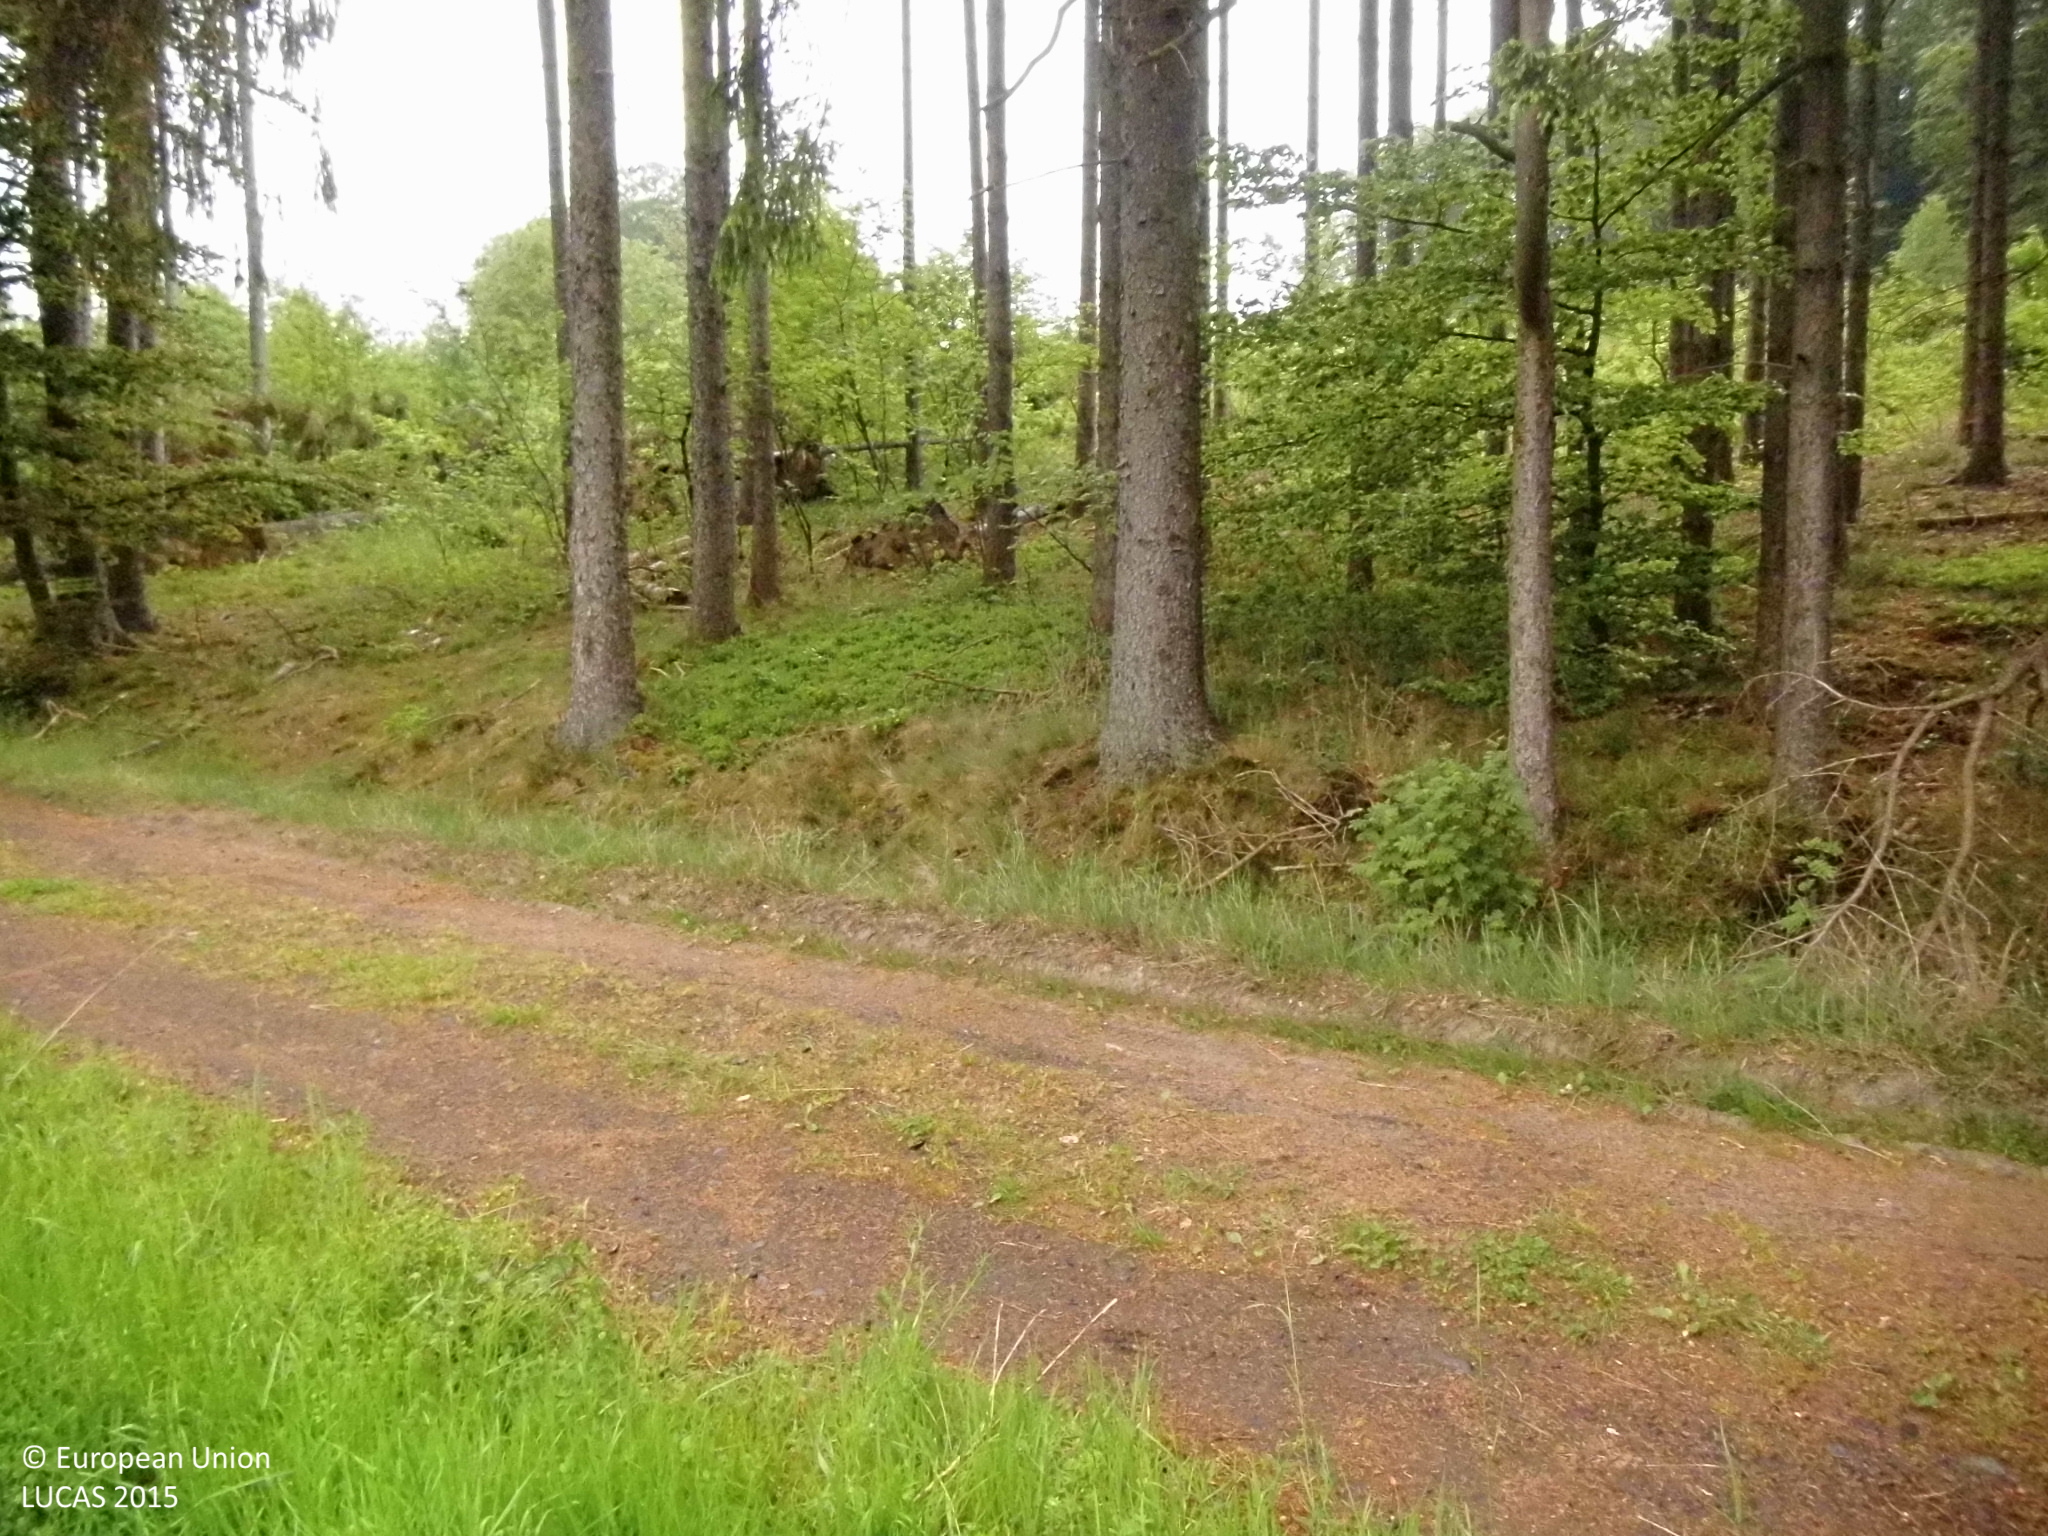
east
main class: Shrubland
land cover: Shrubland with sparse tree cover
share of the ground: > 75 %
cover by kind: herbaceous plants 55 %, shrubs 40 %, broadleaved forest trees 5 %
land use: Semi-natural and natural areas not in use
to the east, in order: Shrubland with sparse tree cover; Tracks; Grass margins; Other mixed woodland; Shrubland with sparse tree cover; Broadleaved woodland; Spontaneously vegetated surfaces; Tracks; Other structural elements; Grassland without tree/shrub cover
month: May
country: DE
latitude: 50.6072
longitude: 7.5274
